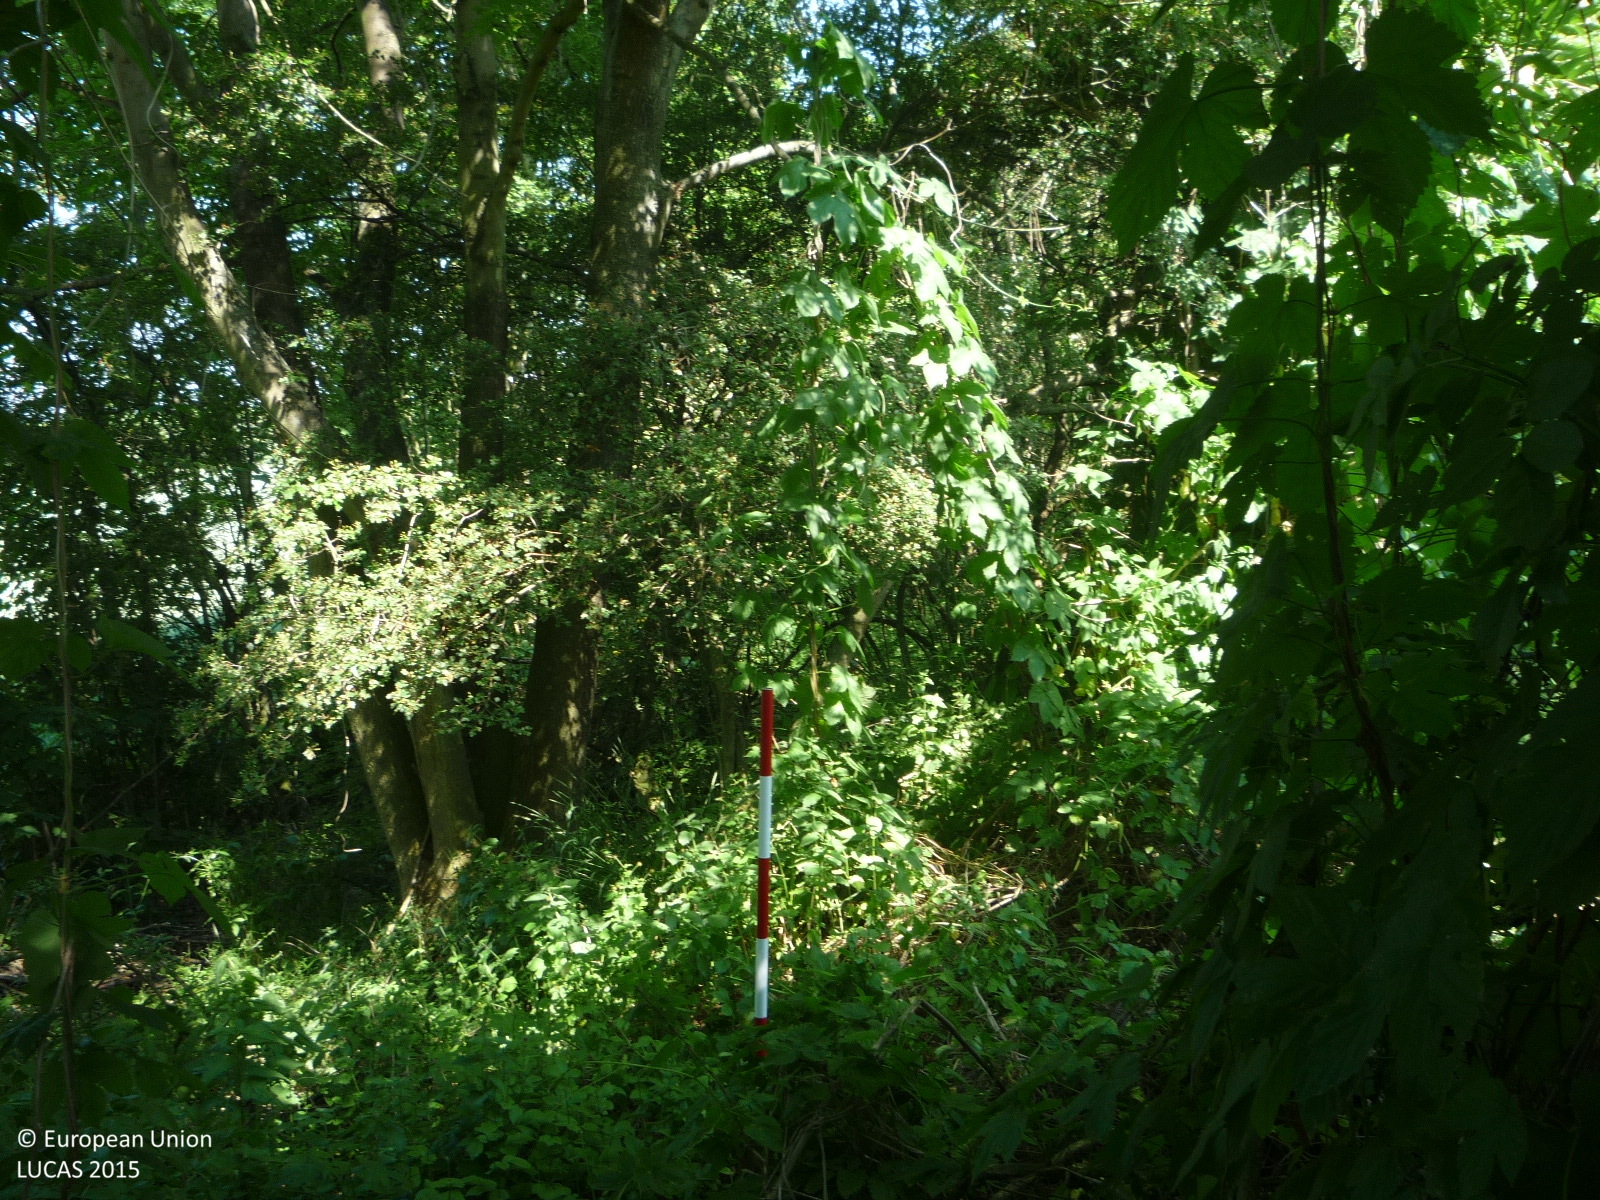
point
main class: Woodland
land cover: Broadleaved woodland
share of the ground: > 75 %
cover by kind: broadleaved forest trees 90 %, shrubs 5 %, herbaceous plants 5 %
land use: Semi-natural and natural areas not in use
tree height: > 5 m
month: June
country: CZ
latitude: 50.2163
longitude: 14.1634
